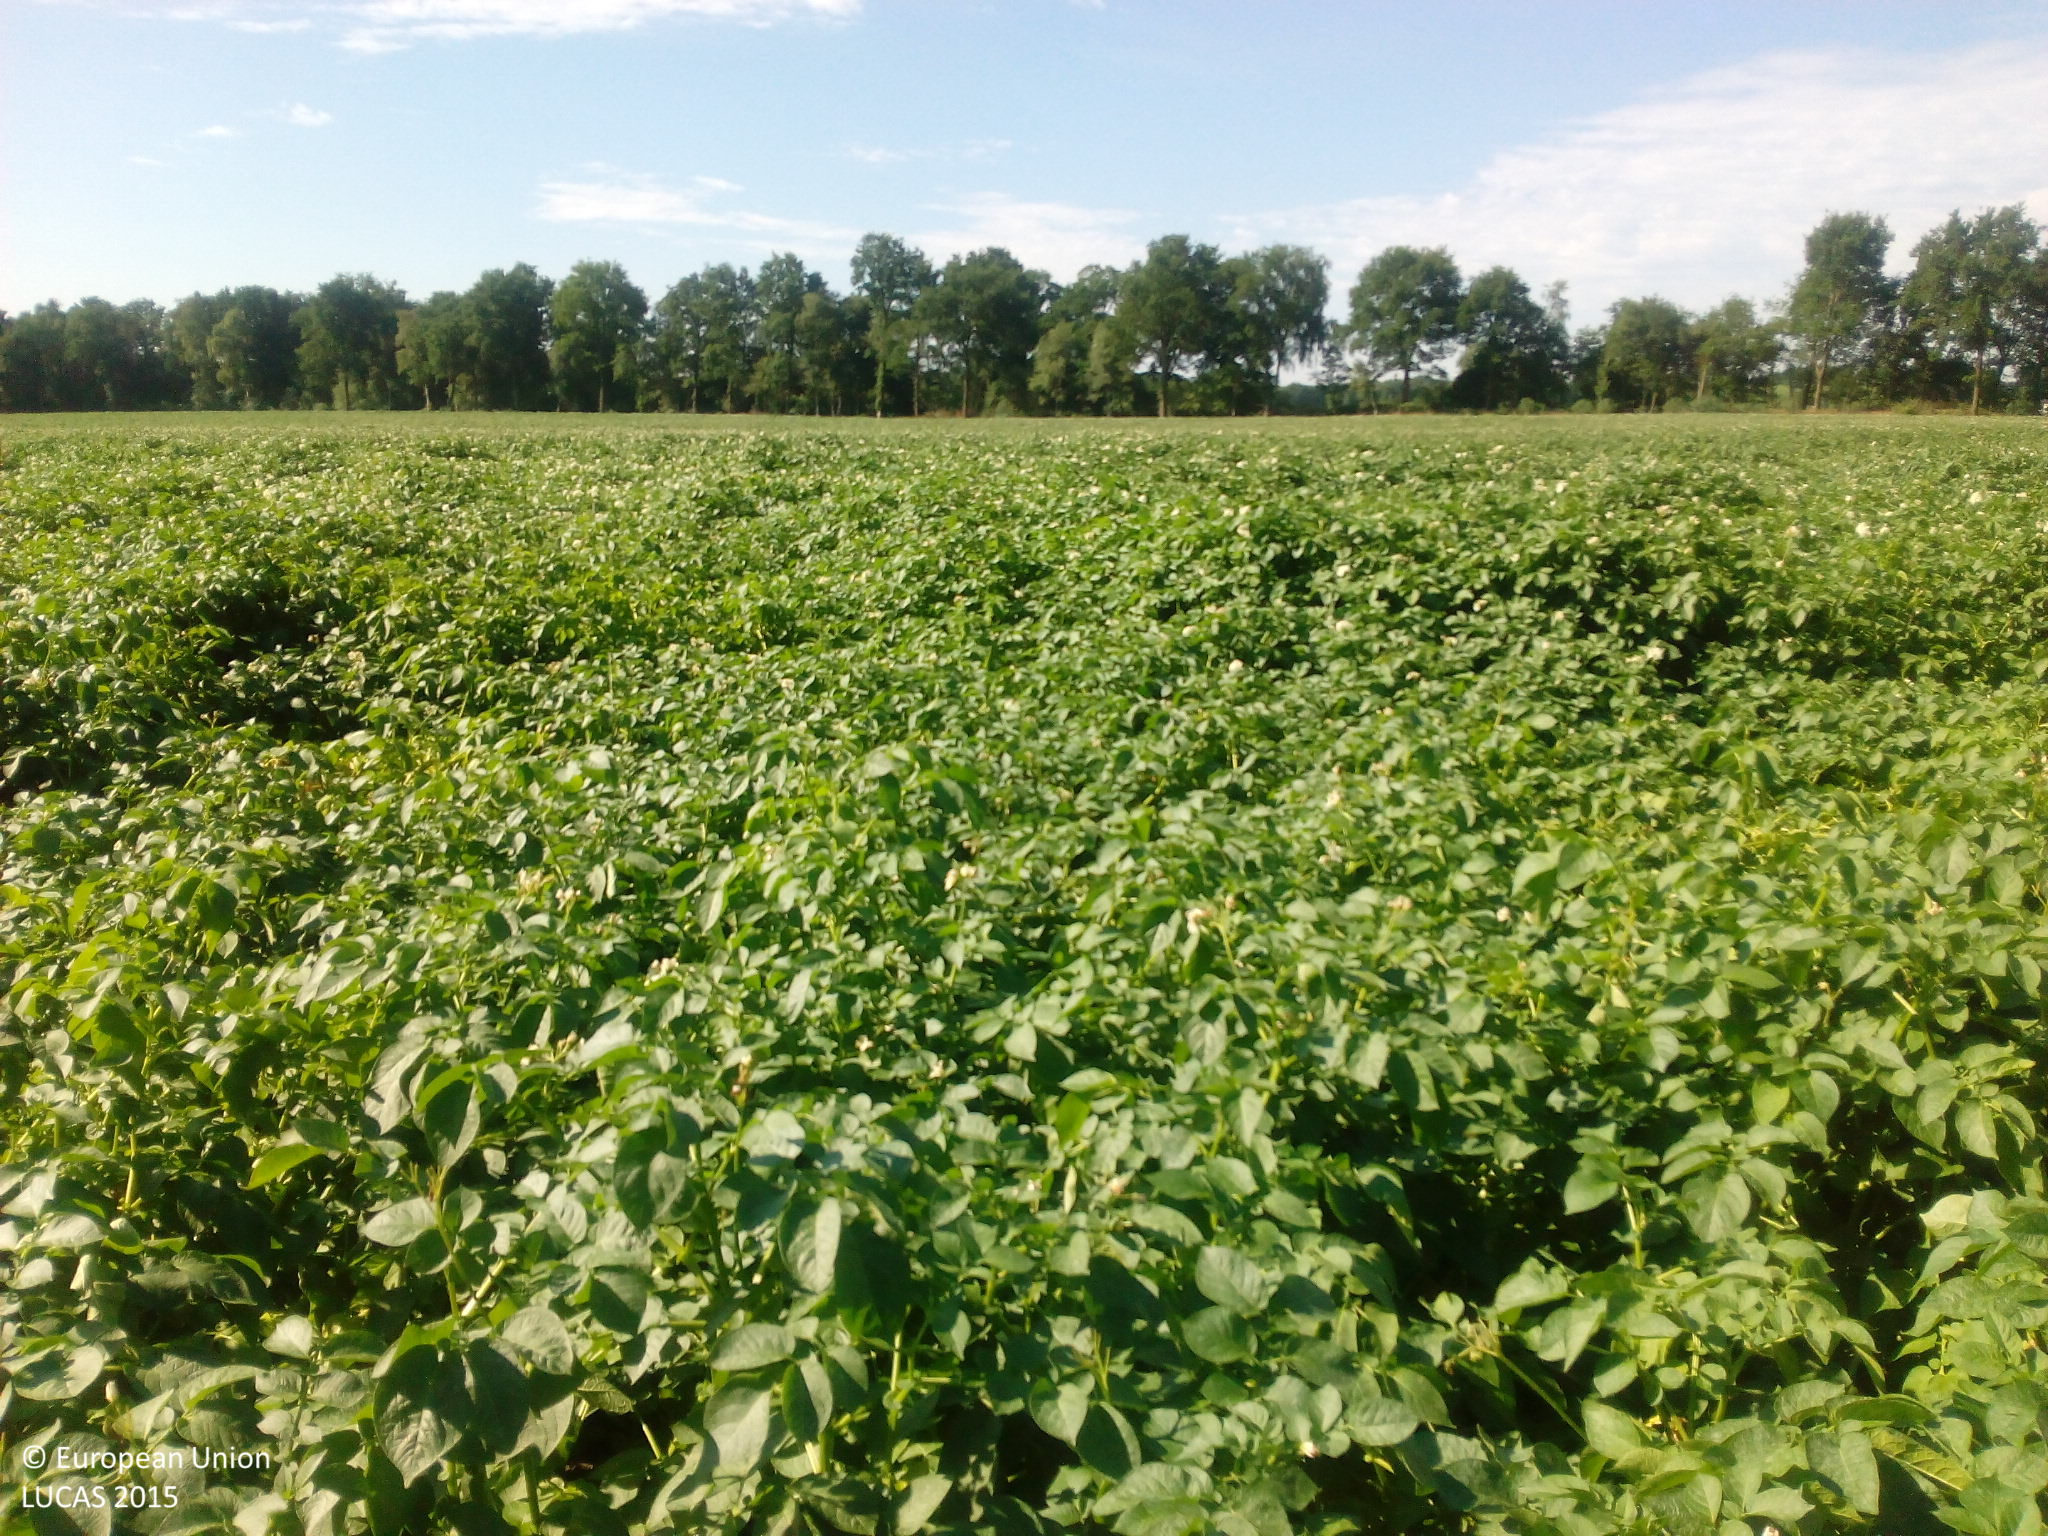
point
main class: Cropland
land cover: Potatoes
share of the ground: > 75 %
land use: Agriculture (excluding fallow land and kitchen gardens)
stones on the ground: < 10 %
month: July
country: DE
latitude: 52.7089
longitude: 7.4102
